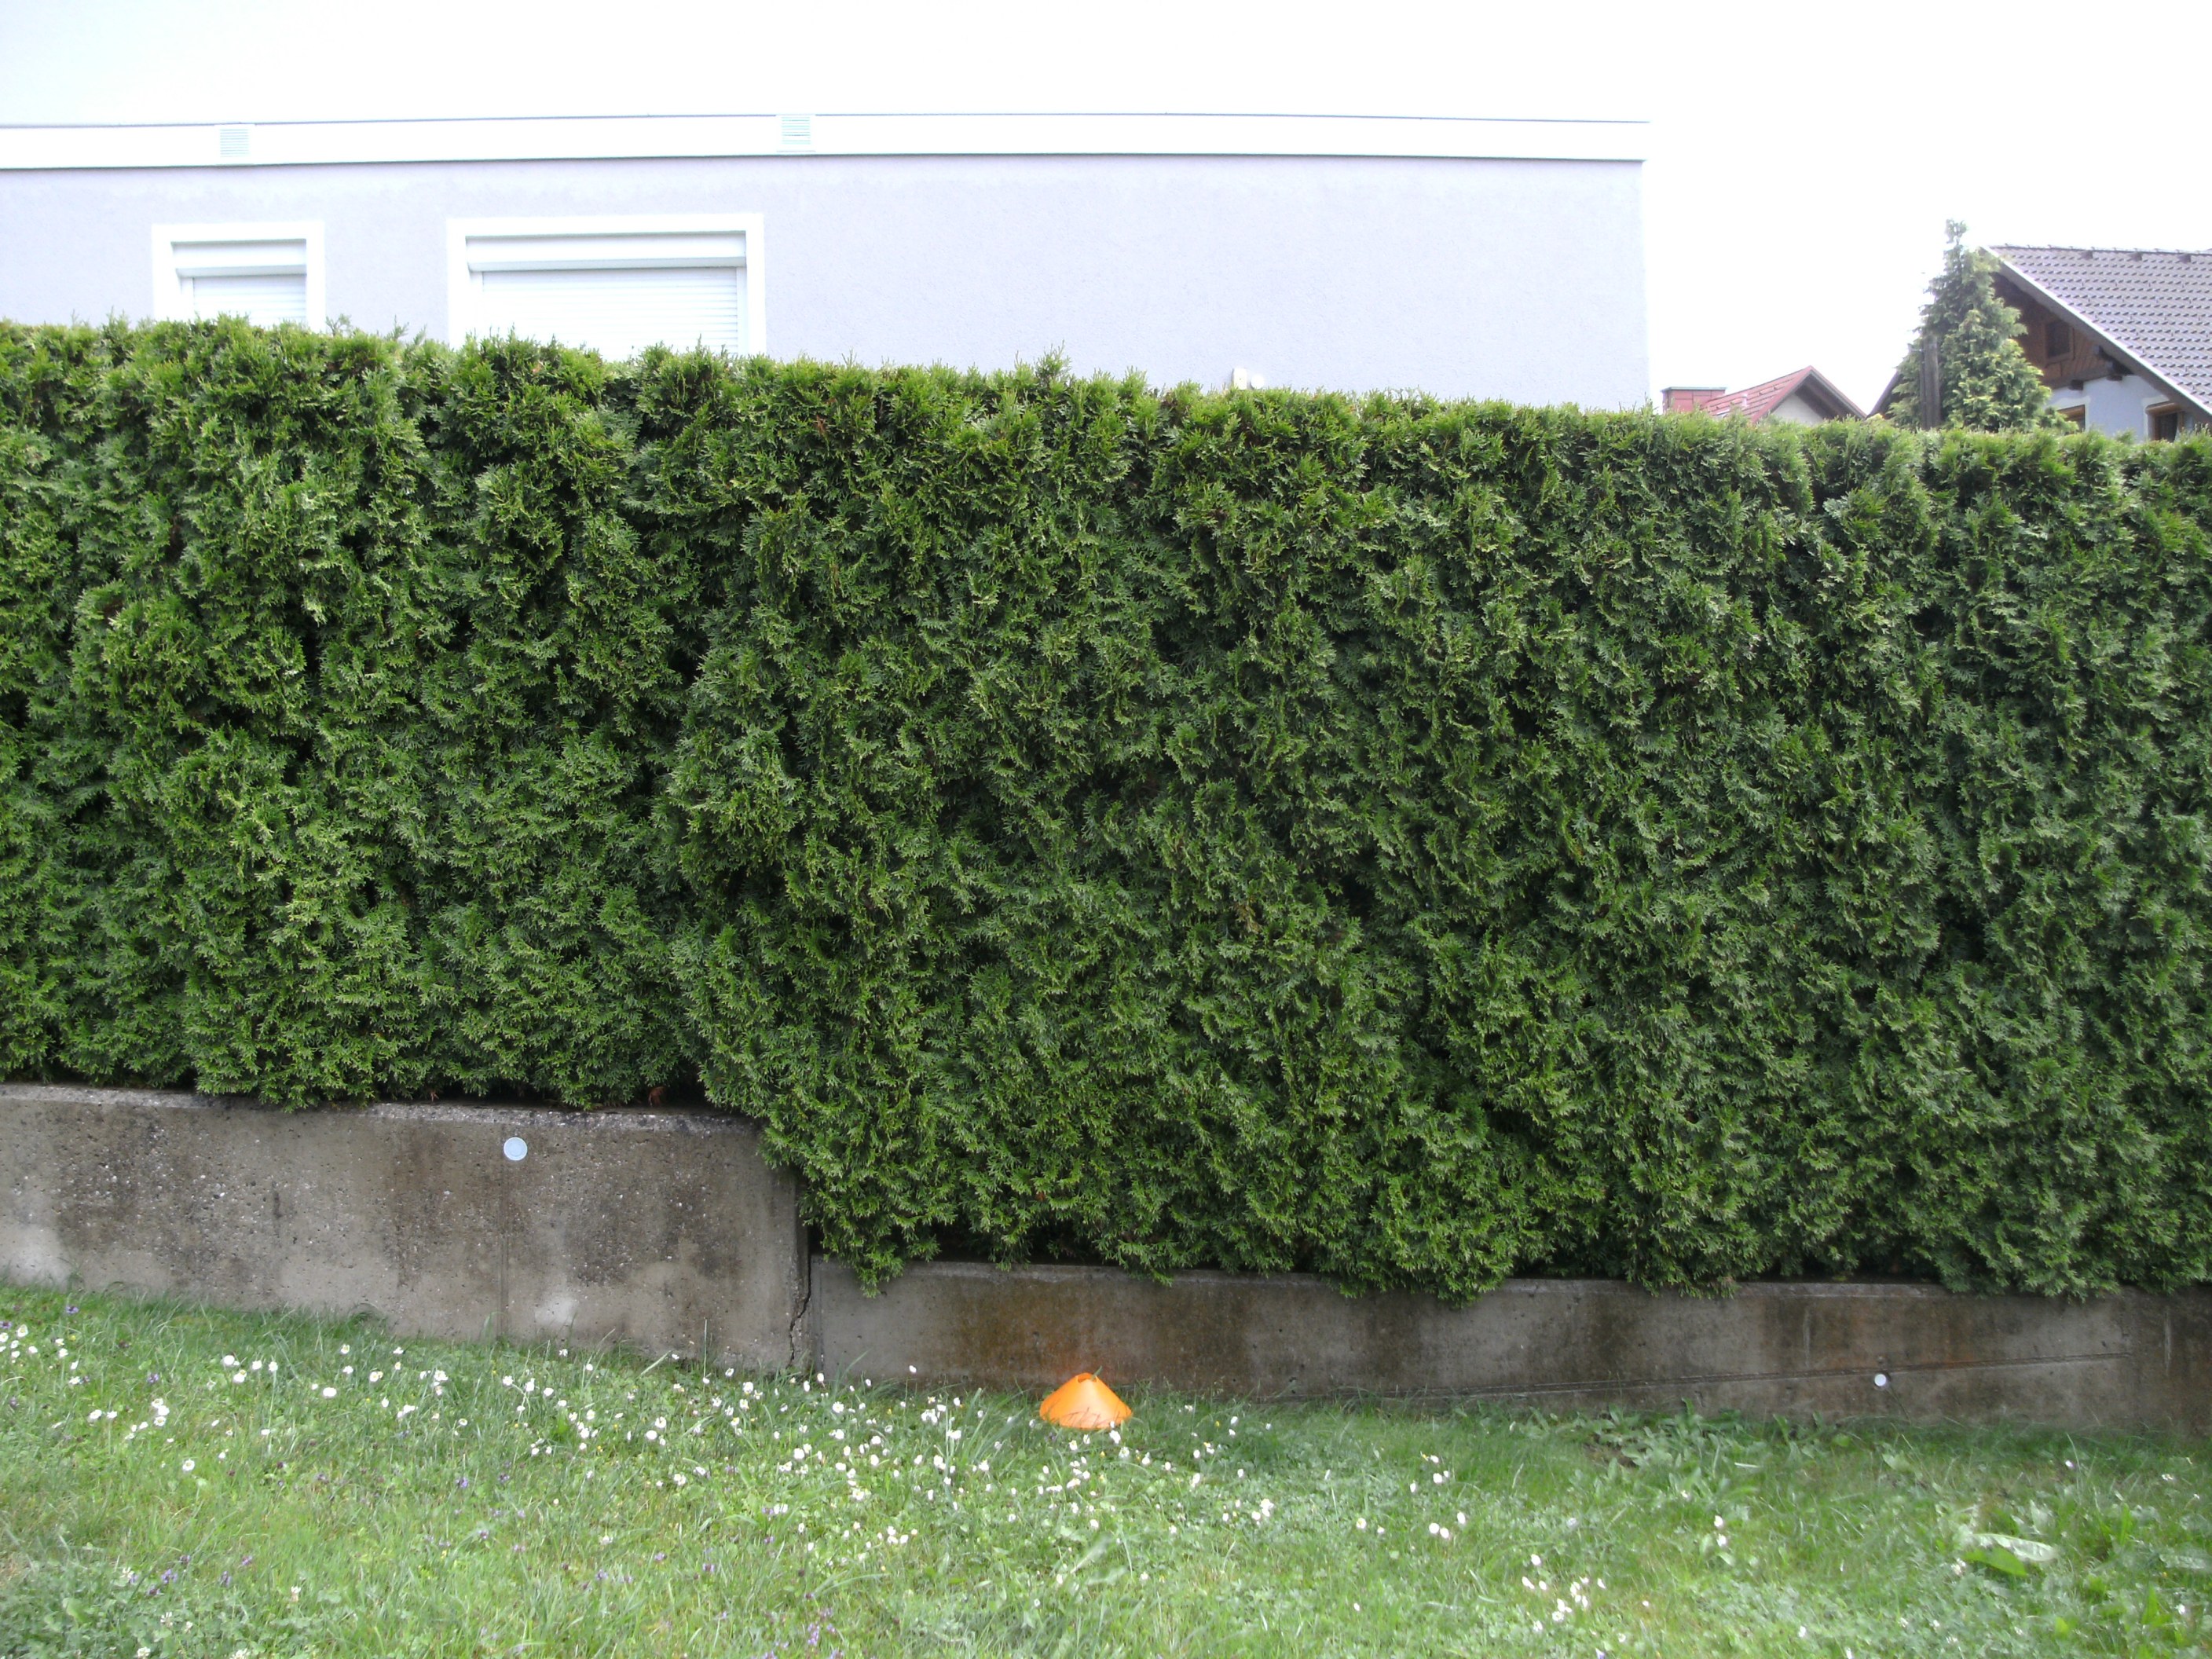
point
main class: Grassland
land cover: Grassland without tree/shrub cover
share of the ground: > 75 %
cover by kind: herbaceous plants 100 %
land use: Residential
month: July
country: AT
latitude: 46.9652
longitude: 14.7956
